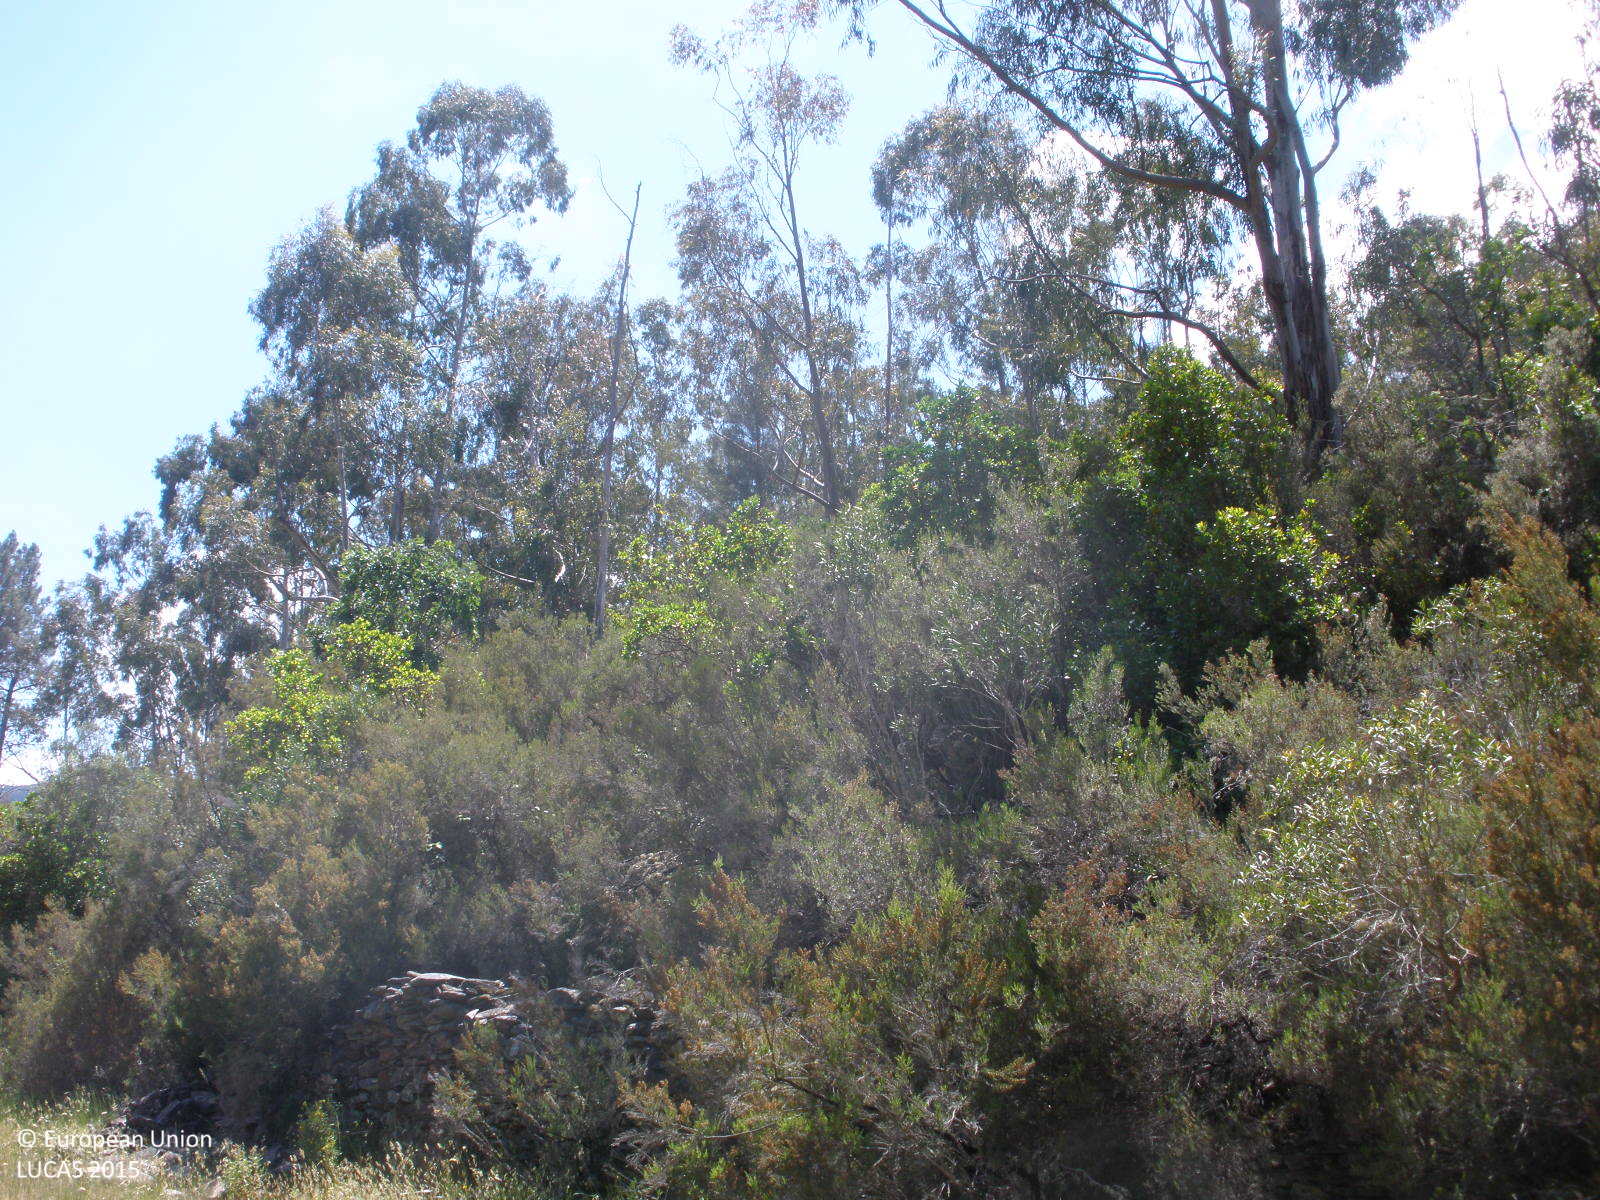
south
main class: Grassland
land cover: Grassland without tree/shrub cover
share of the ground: > 75 %
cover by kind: herbaceous plants 100 %
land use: Agriculture (excluding fallow land and kitchen gardens)
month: May
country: ES
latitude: 40.3602
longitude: -6.0071
